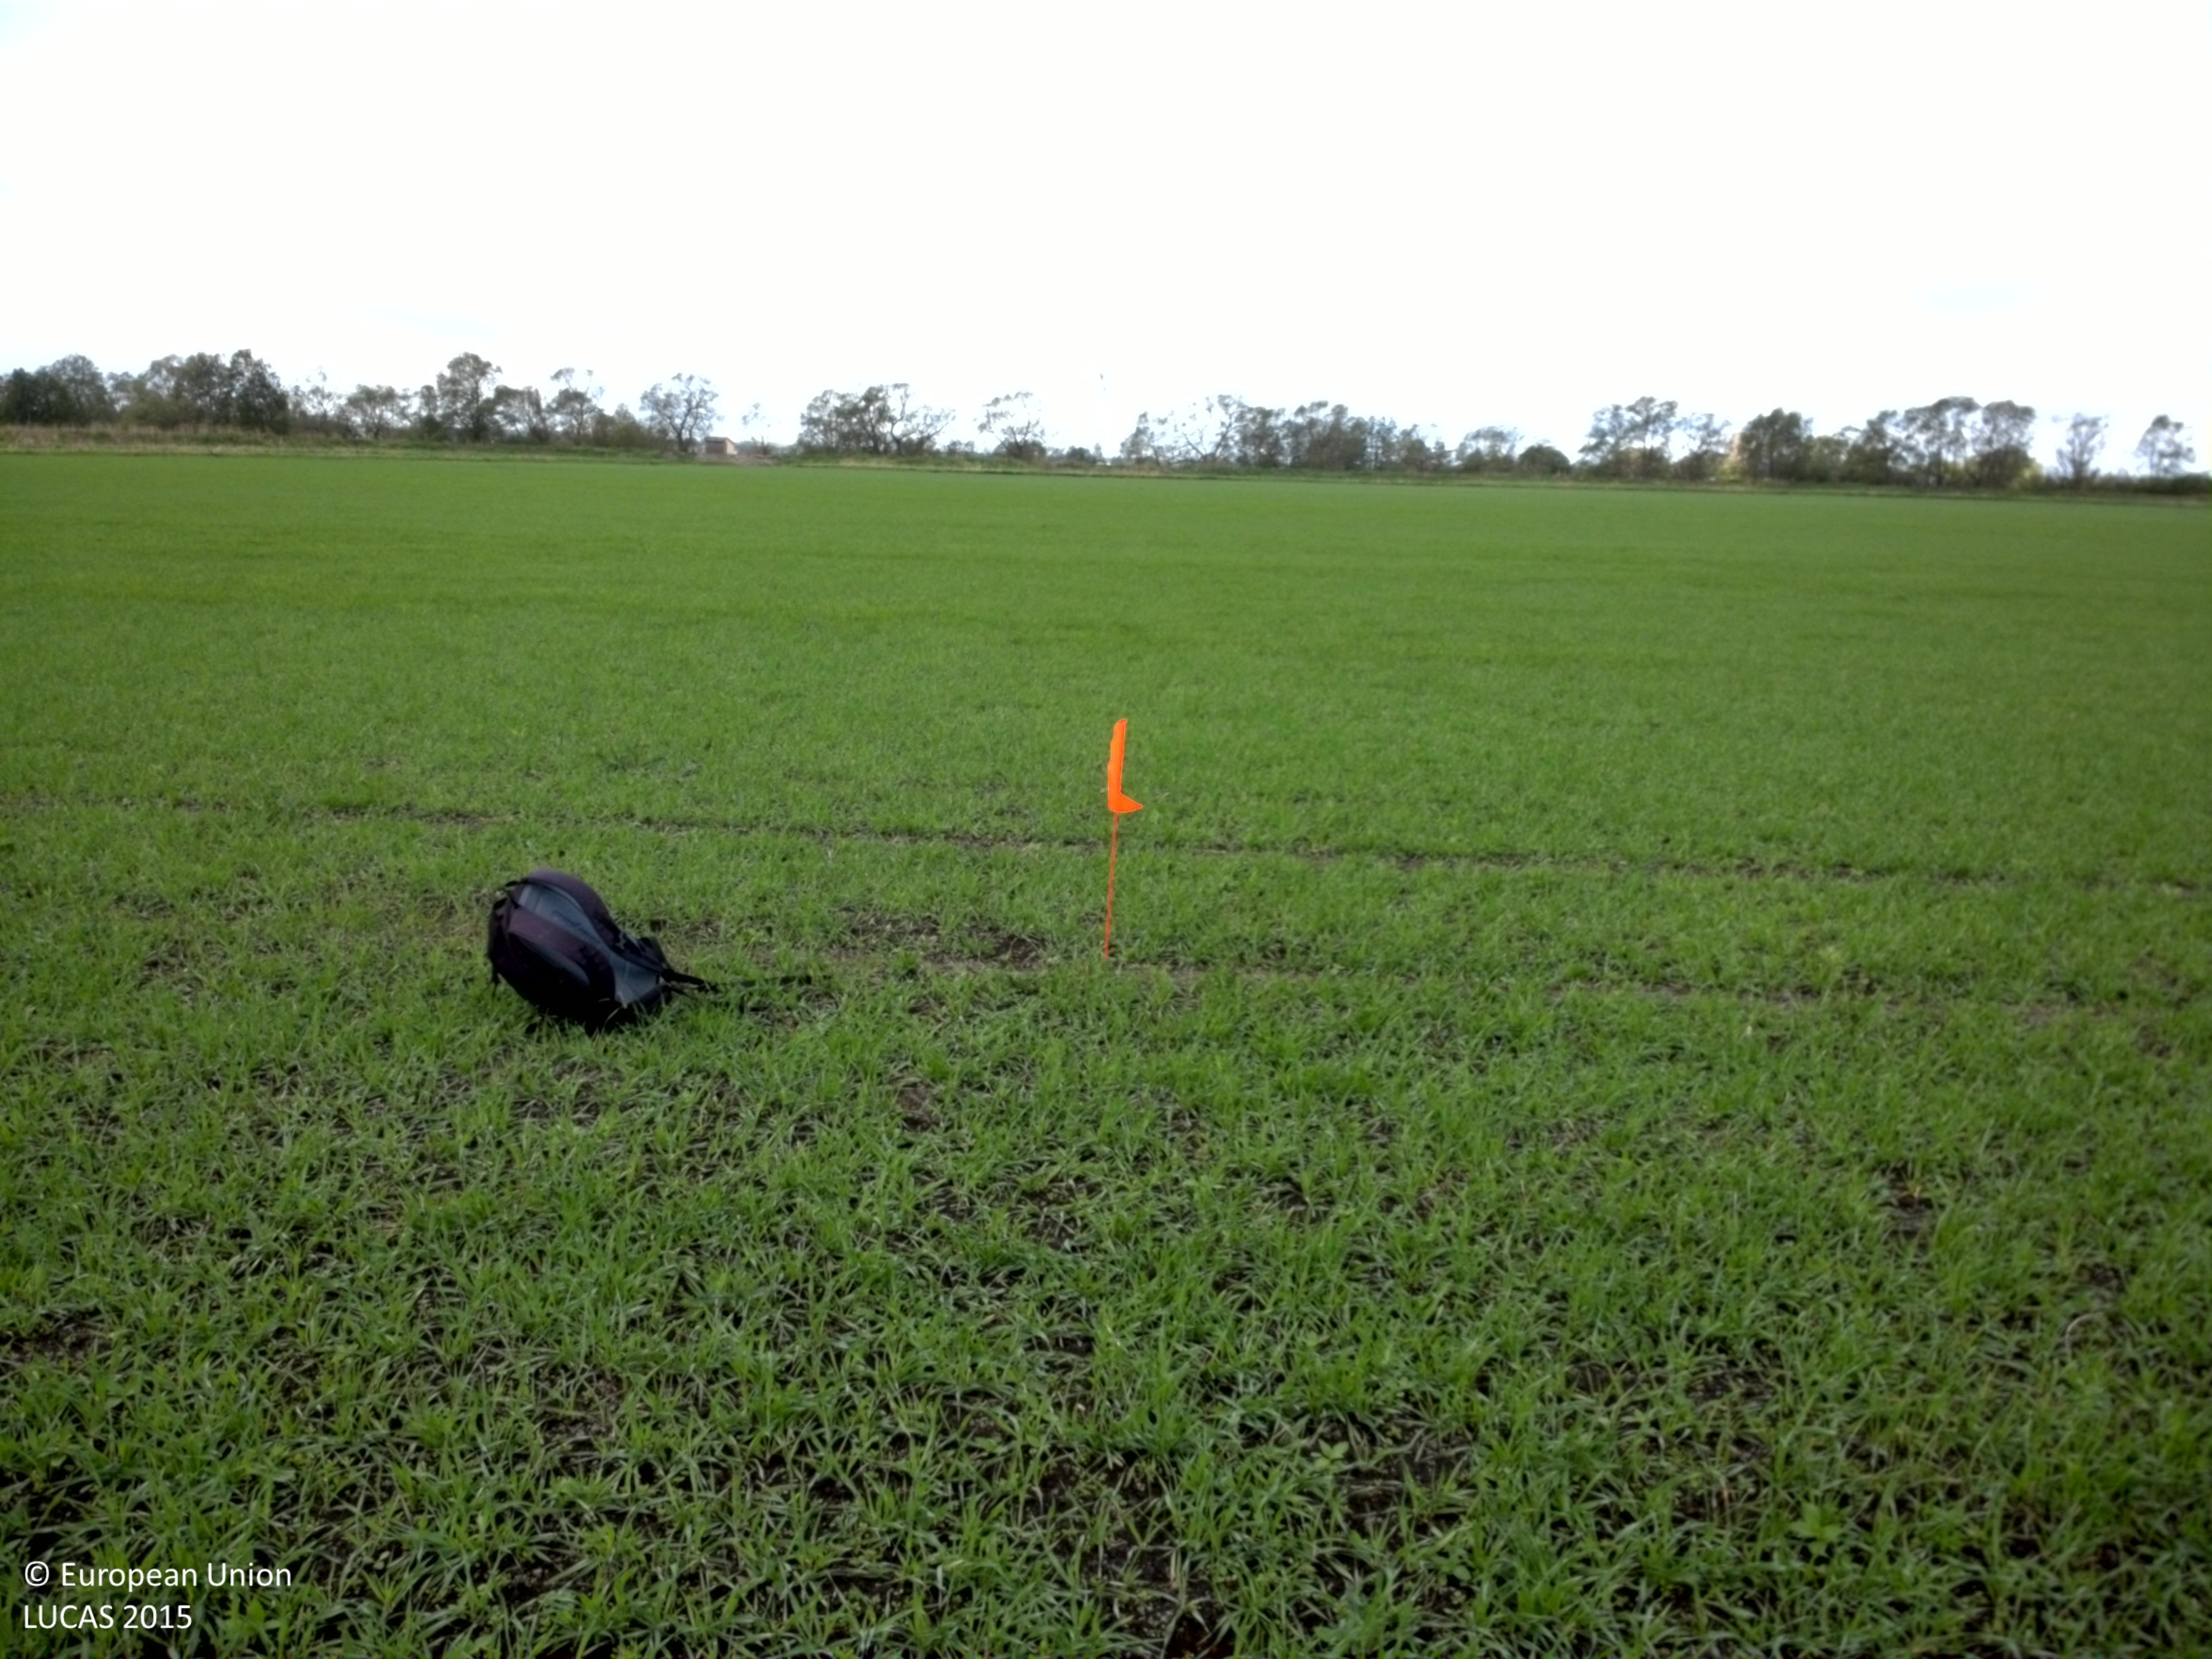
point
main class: Cropland
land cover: Common wheat
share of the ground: 50 - 75 %
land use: Agriculture (excluding fallow land and kitchen gardens)
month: June
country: SE
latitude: 58.4443
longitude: 15.6310
